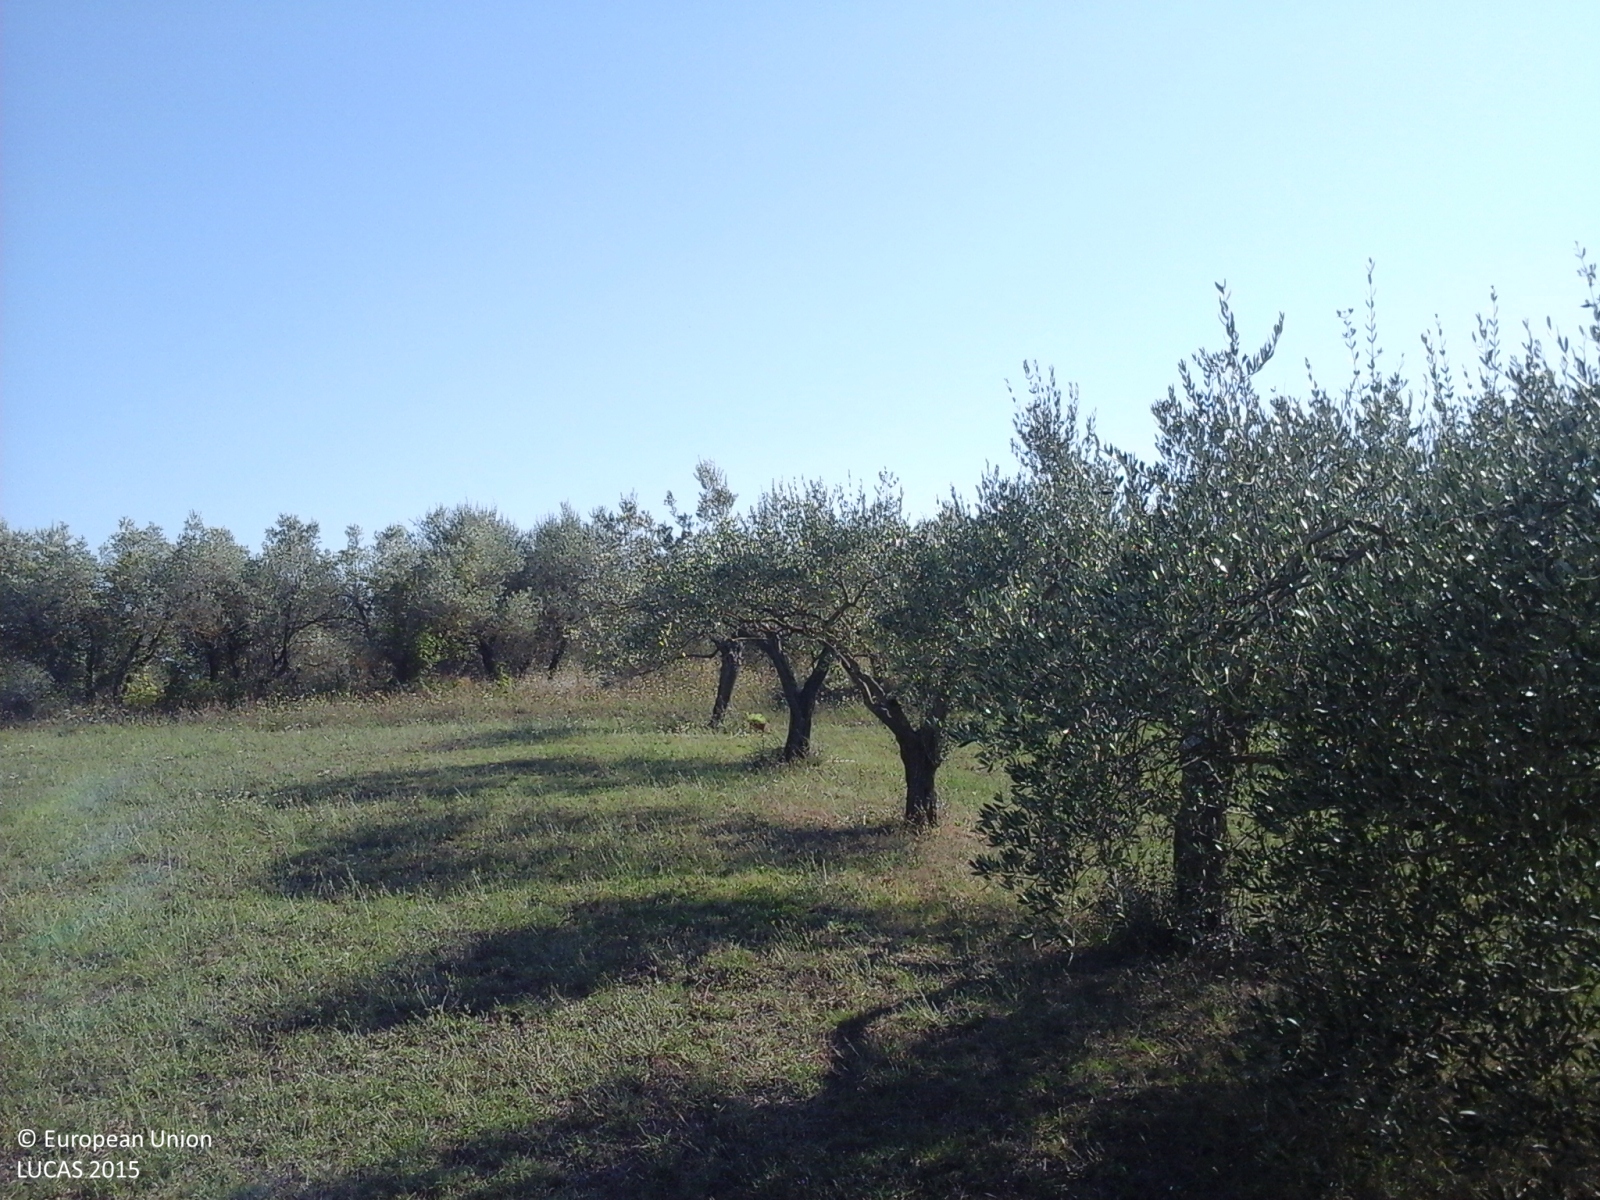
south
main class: Cropland
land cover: Olive groves
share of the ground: 10 - 25 %
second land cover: Grassland without tree/shrub cover
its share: > 75 %
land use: Agriculture (excluding fallow land and kitchen gardens)
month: August
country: IT
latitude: 42.8615
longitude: 12.3550
